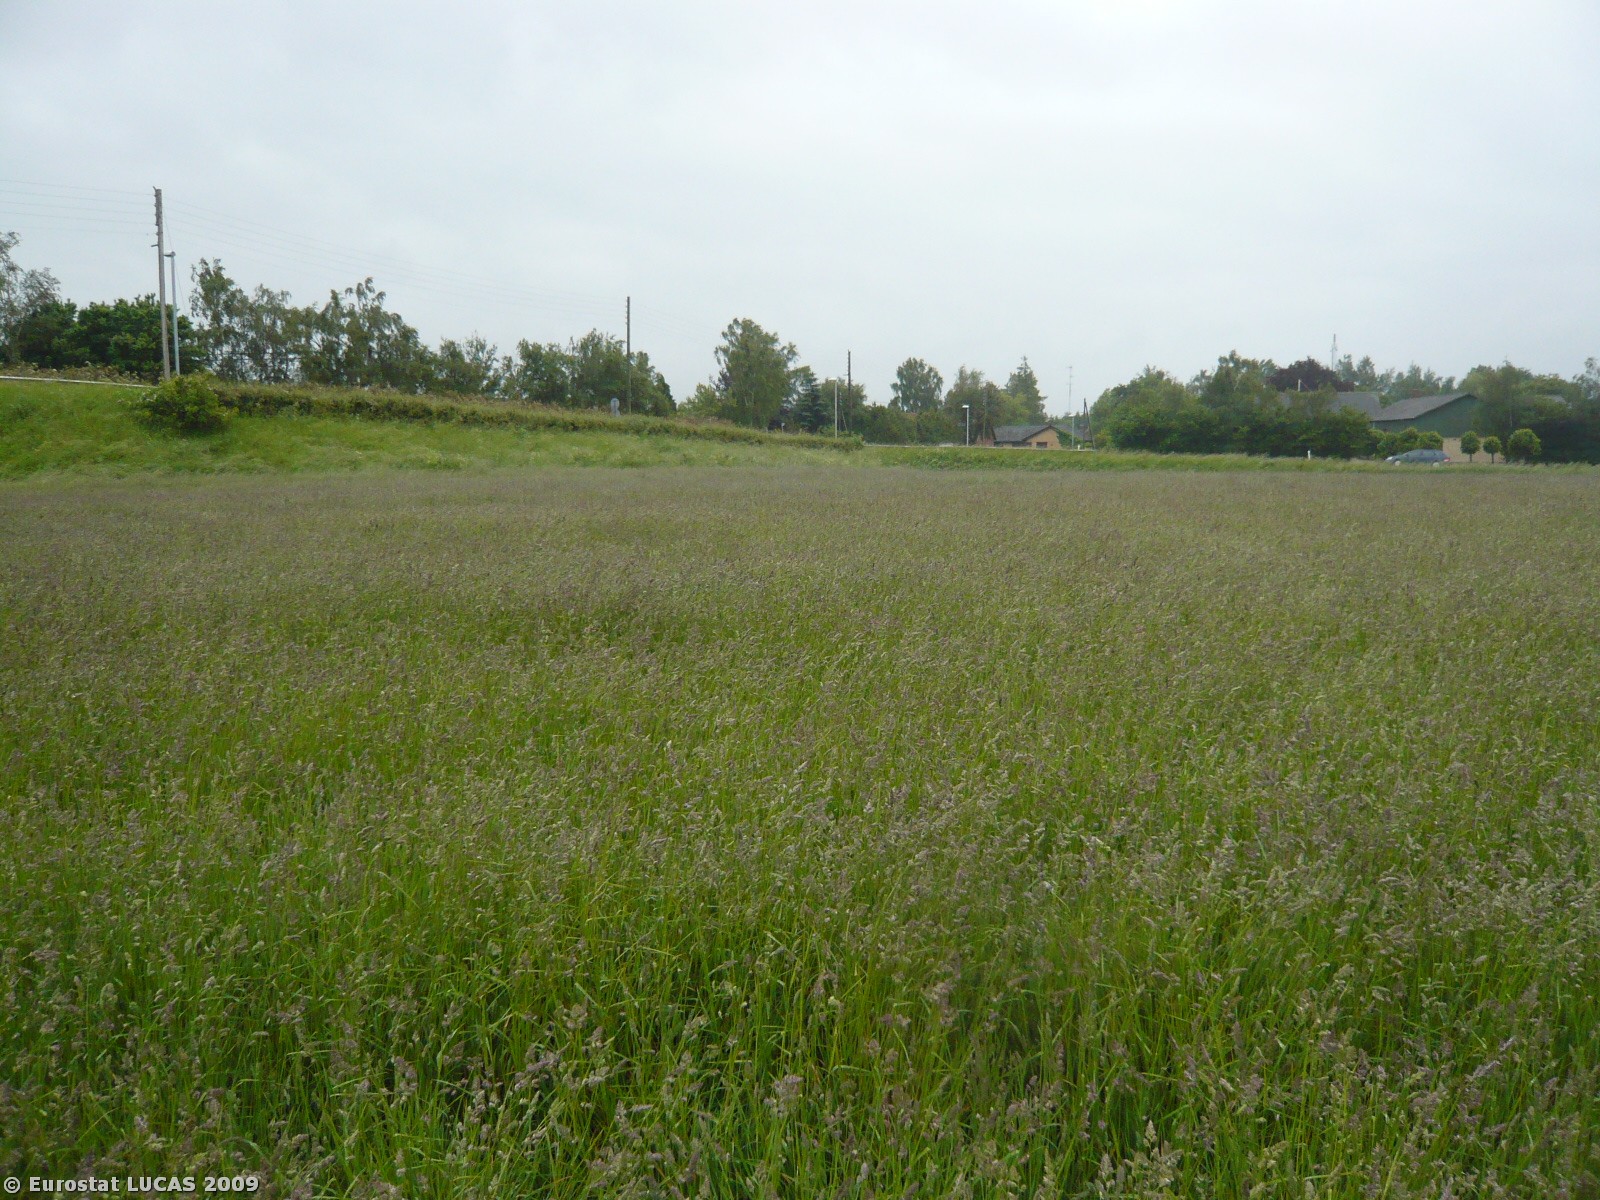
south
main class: Cropland
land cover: Temporary grasslands
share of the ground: > 75 %
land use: Agriculture (excluding fallow land and kitchen gardens)
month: June
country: DK
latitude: 54.8614
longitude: 11.8839
